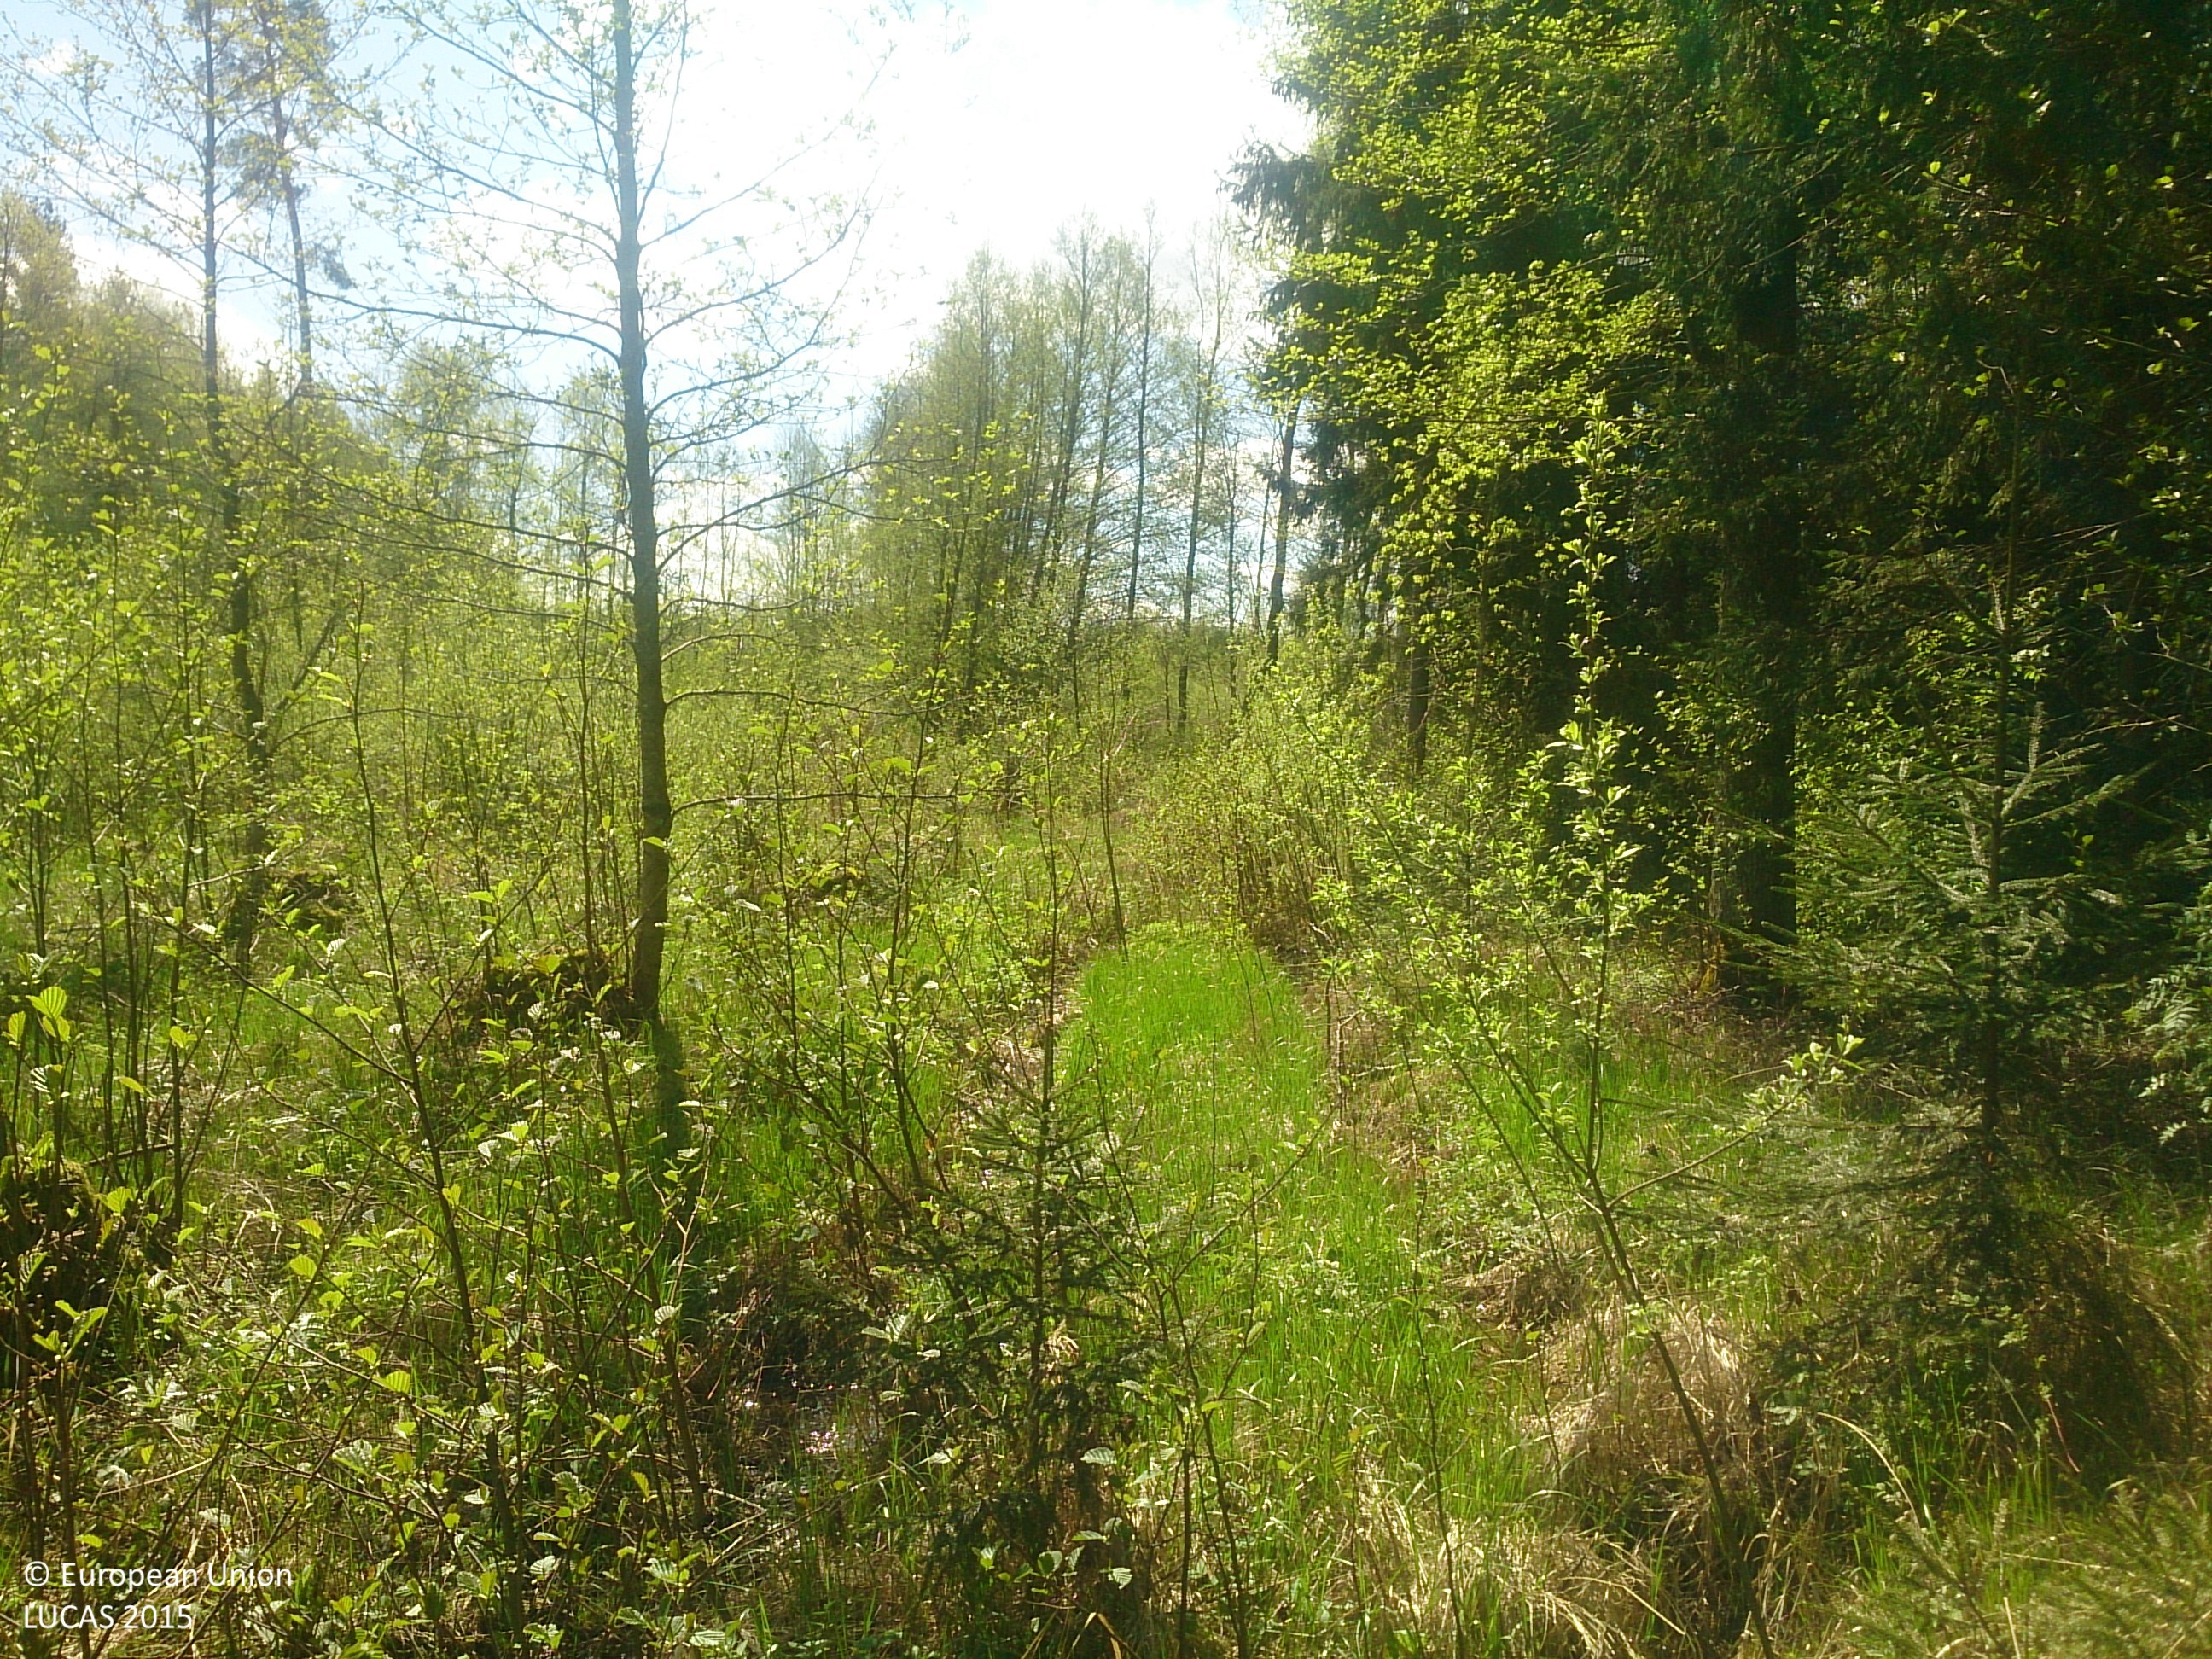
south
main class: Woodland
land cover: Spruce dominated mixed woodland
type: hemiboreal forest and nemoral coniferous forest and mixed broadleaved-coniferous forest
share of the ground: 25 - 50 %
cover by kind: herbaceous plants 50 %, broadleaved forest trees 25 %, coniferous forest trees 20 %, shrubs 5 %
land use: Forestry
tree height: < 5 m
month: May
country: LV
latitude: 56.7709
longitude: 24.1420
